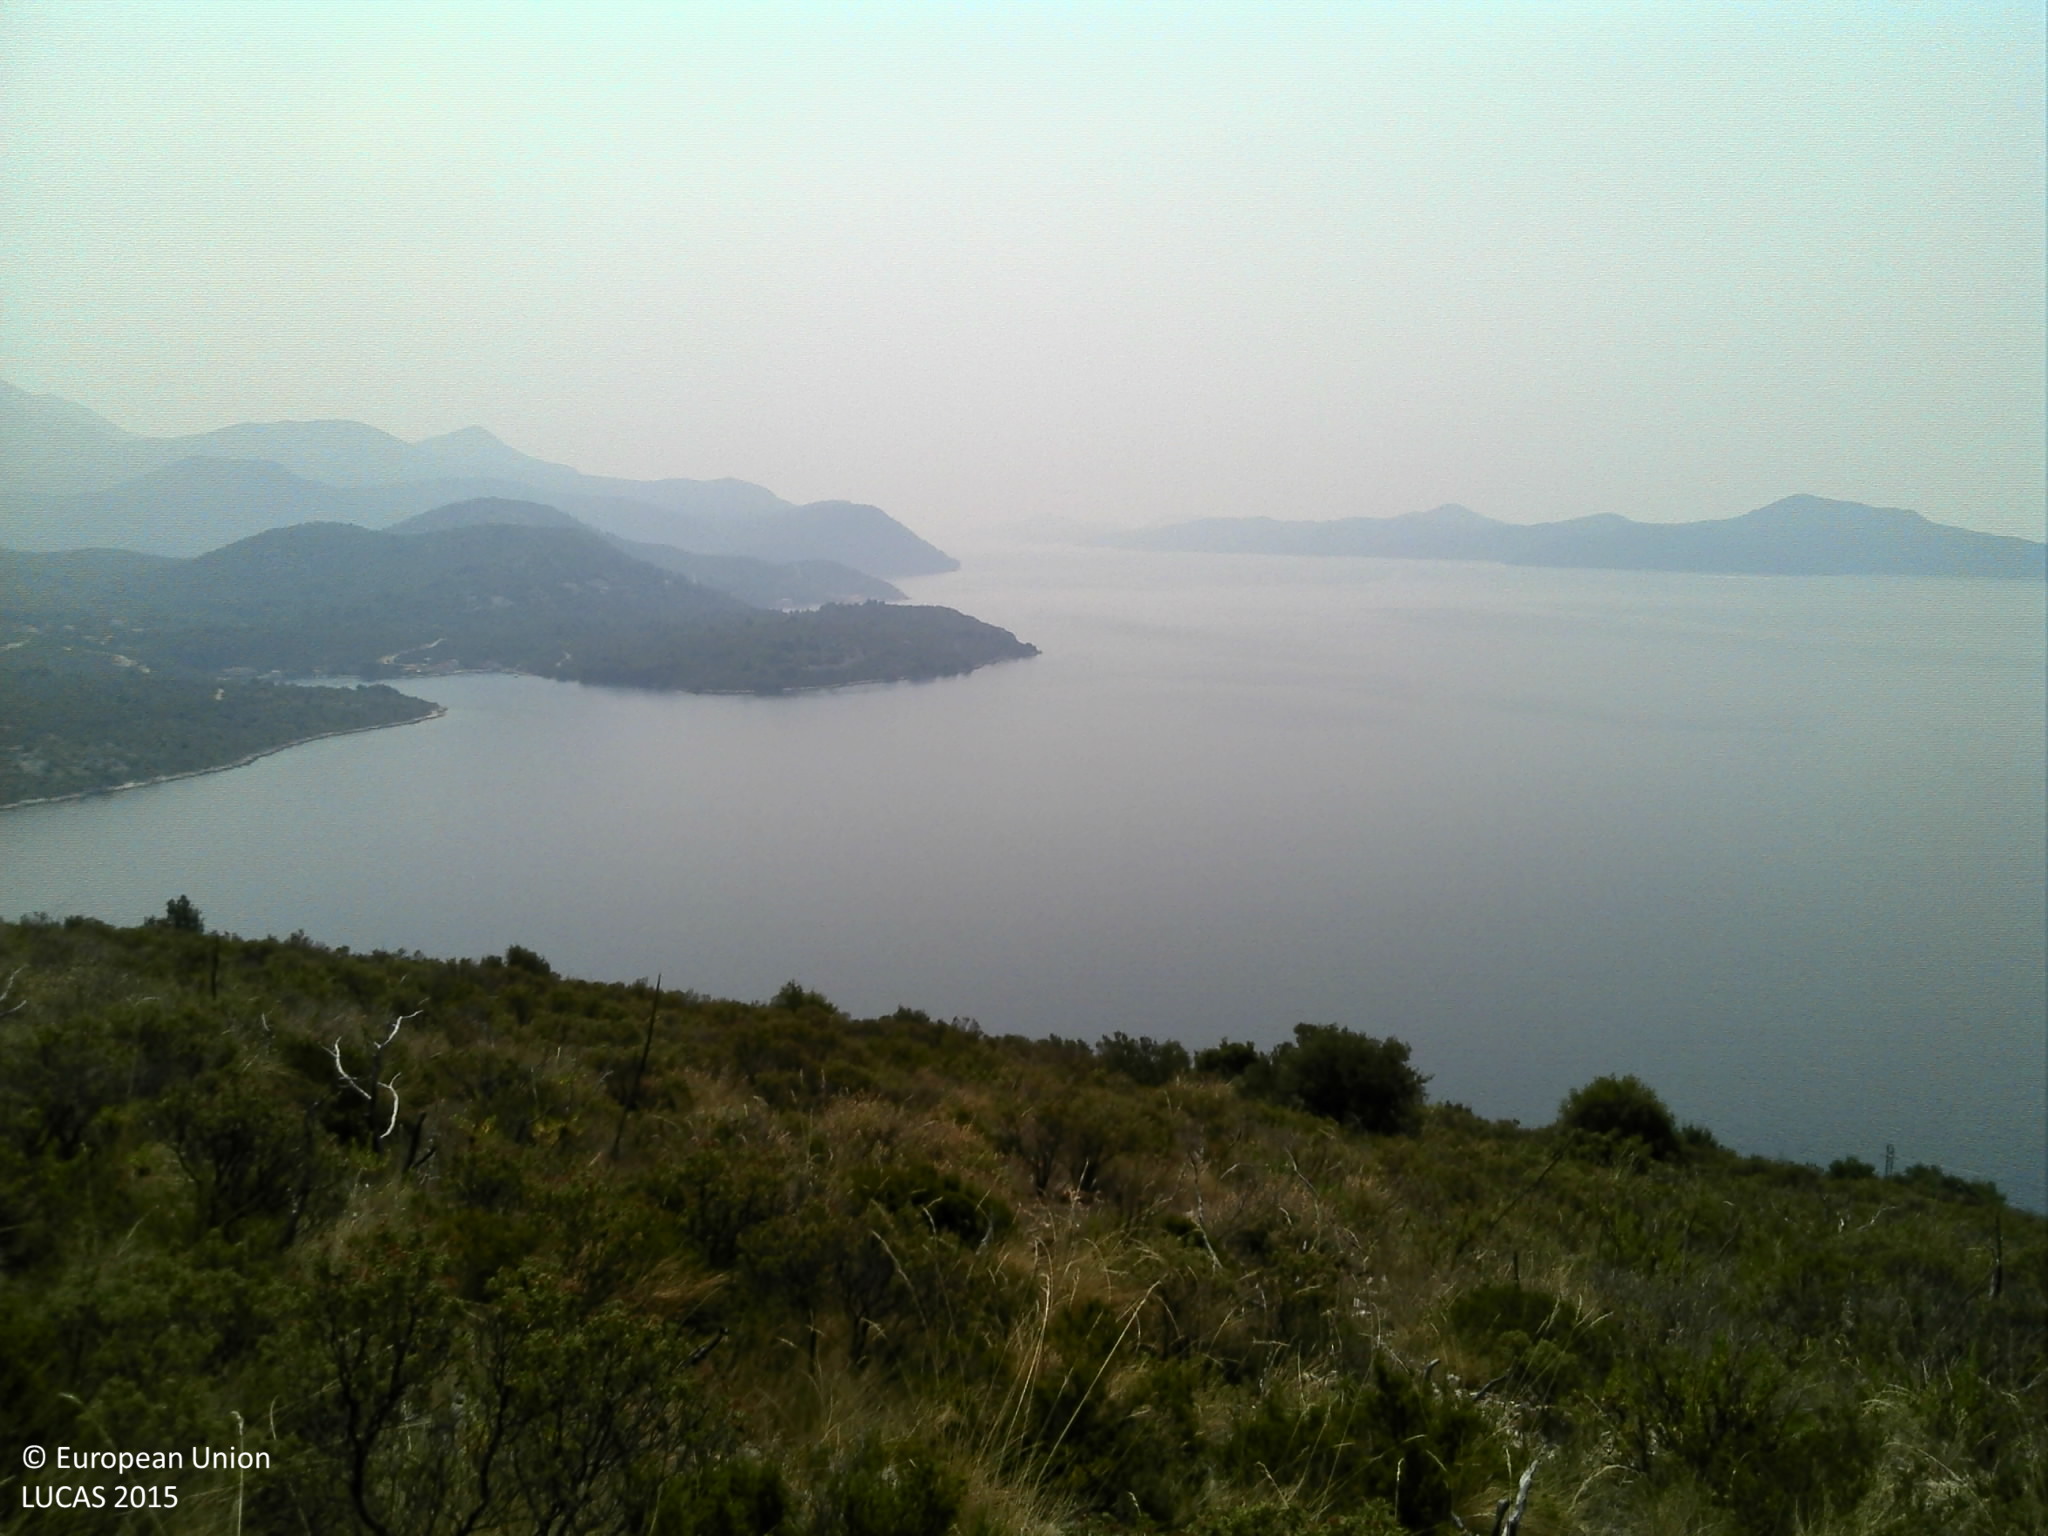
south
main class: Shrubland
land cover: Shrubland without tree cover
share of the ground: 50 - 75 %
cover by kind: shrubs 50 %, herbaceous plants 25 %, consolidated bare surface 25 %
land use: Semi-natural and natural areas not in use
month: July
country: HR
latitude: 42.8041
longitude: 17.8284
